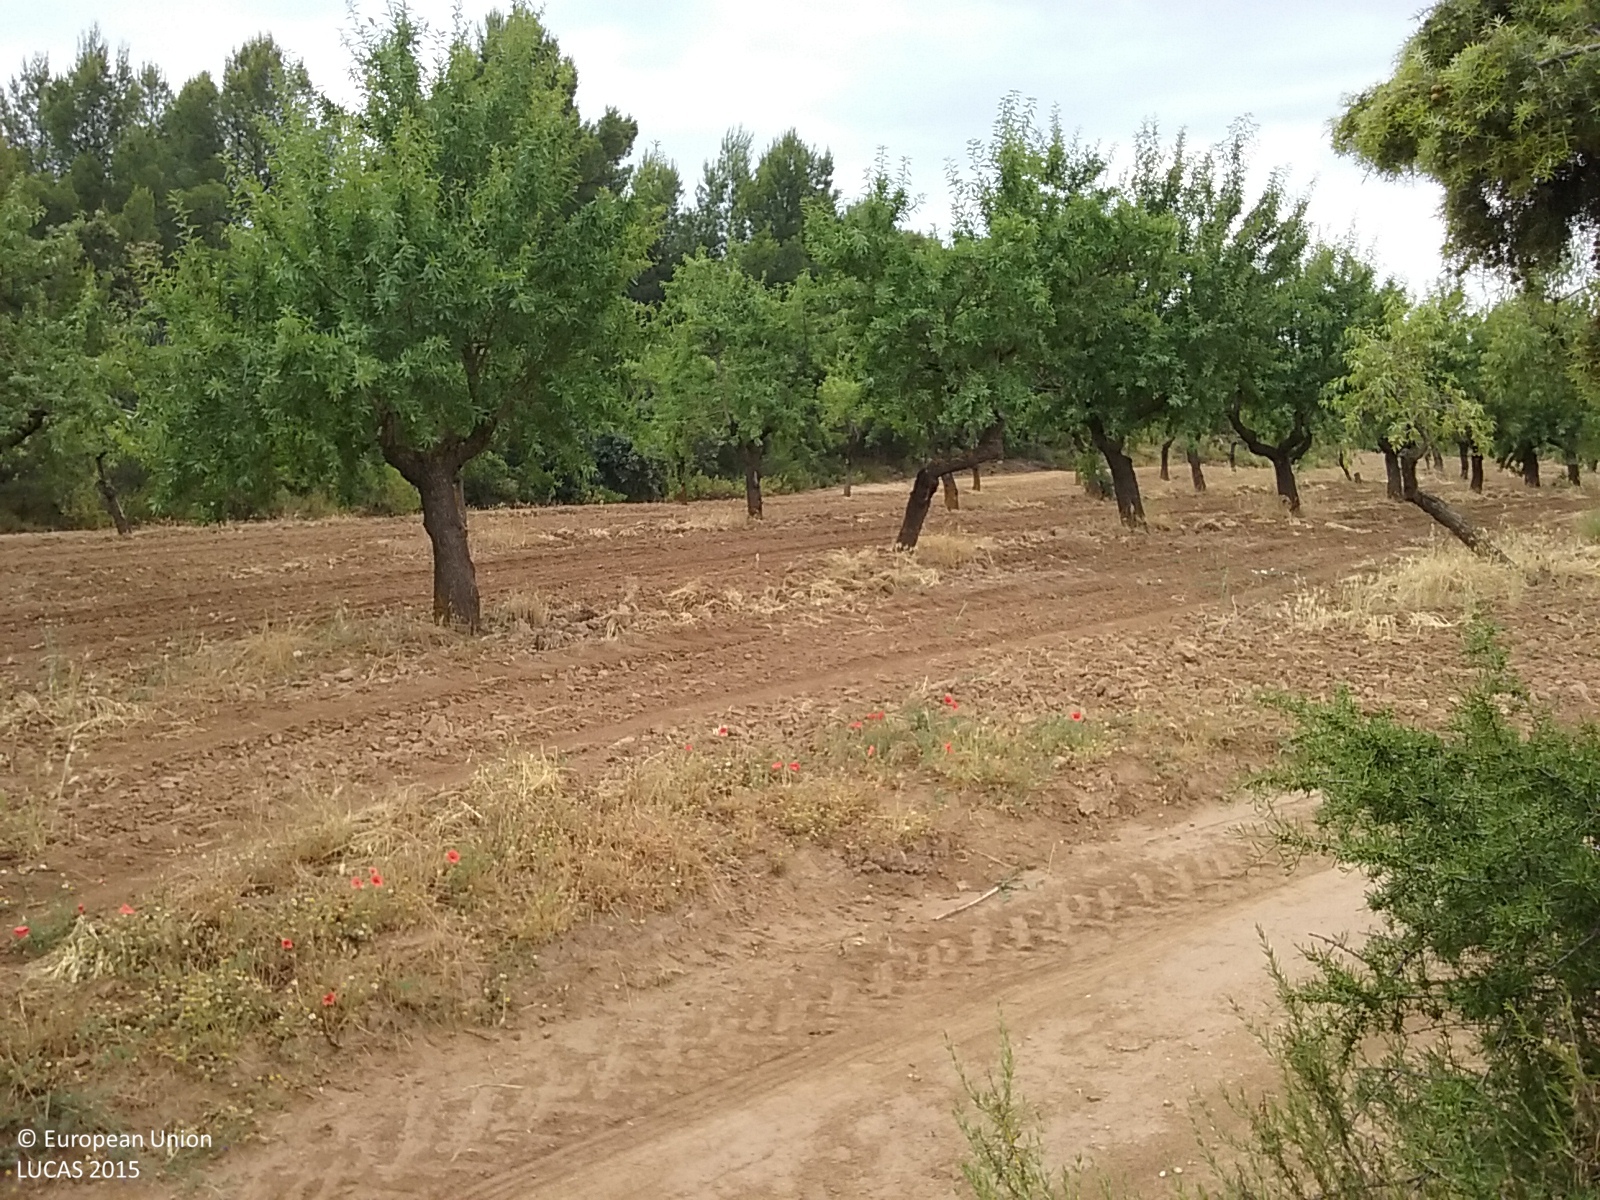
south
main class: Woodland
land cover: Broadleaved woodland
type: broadleaved evergreen forest
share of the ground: > 75 %
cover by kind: broadleaved forest trees 90 %, shrubs 10 %
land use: Semi-natural and natural areas not in use
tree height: > 5 m
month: June
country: ES
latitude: 40.9556
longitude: 0.1658
